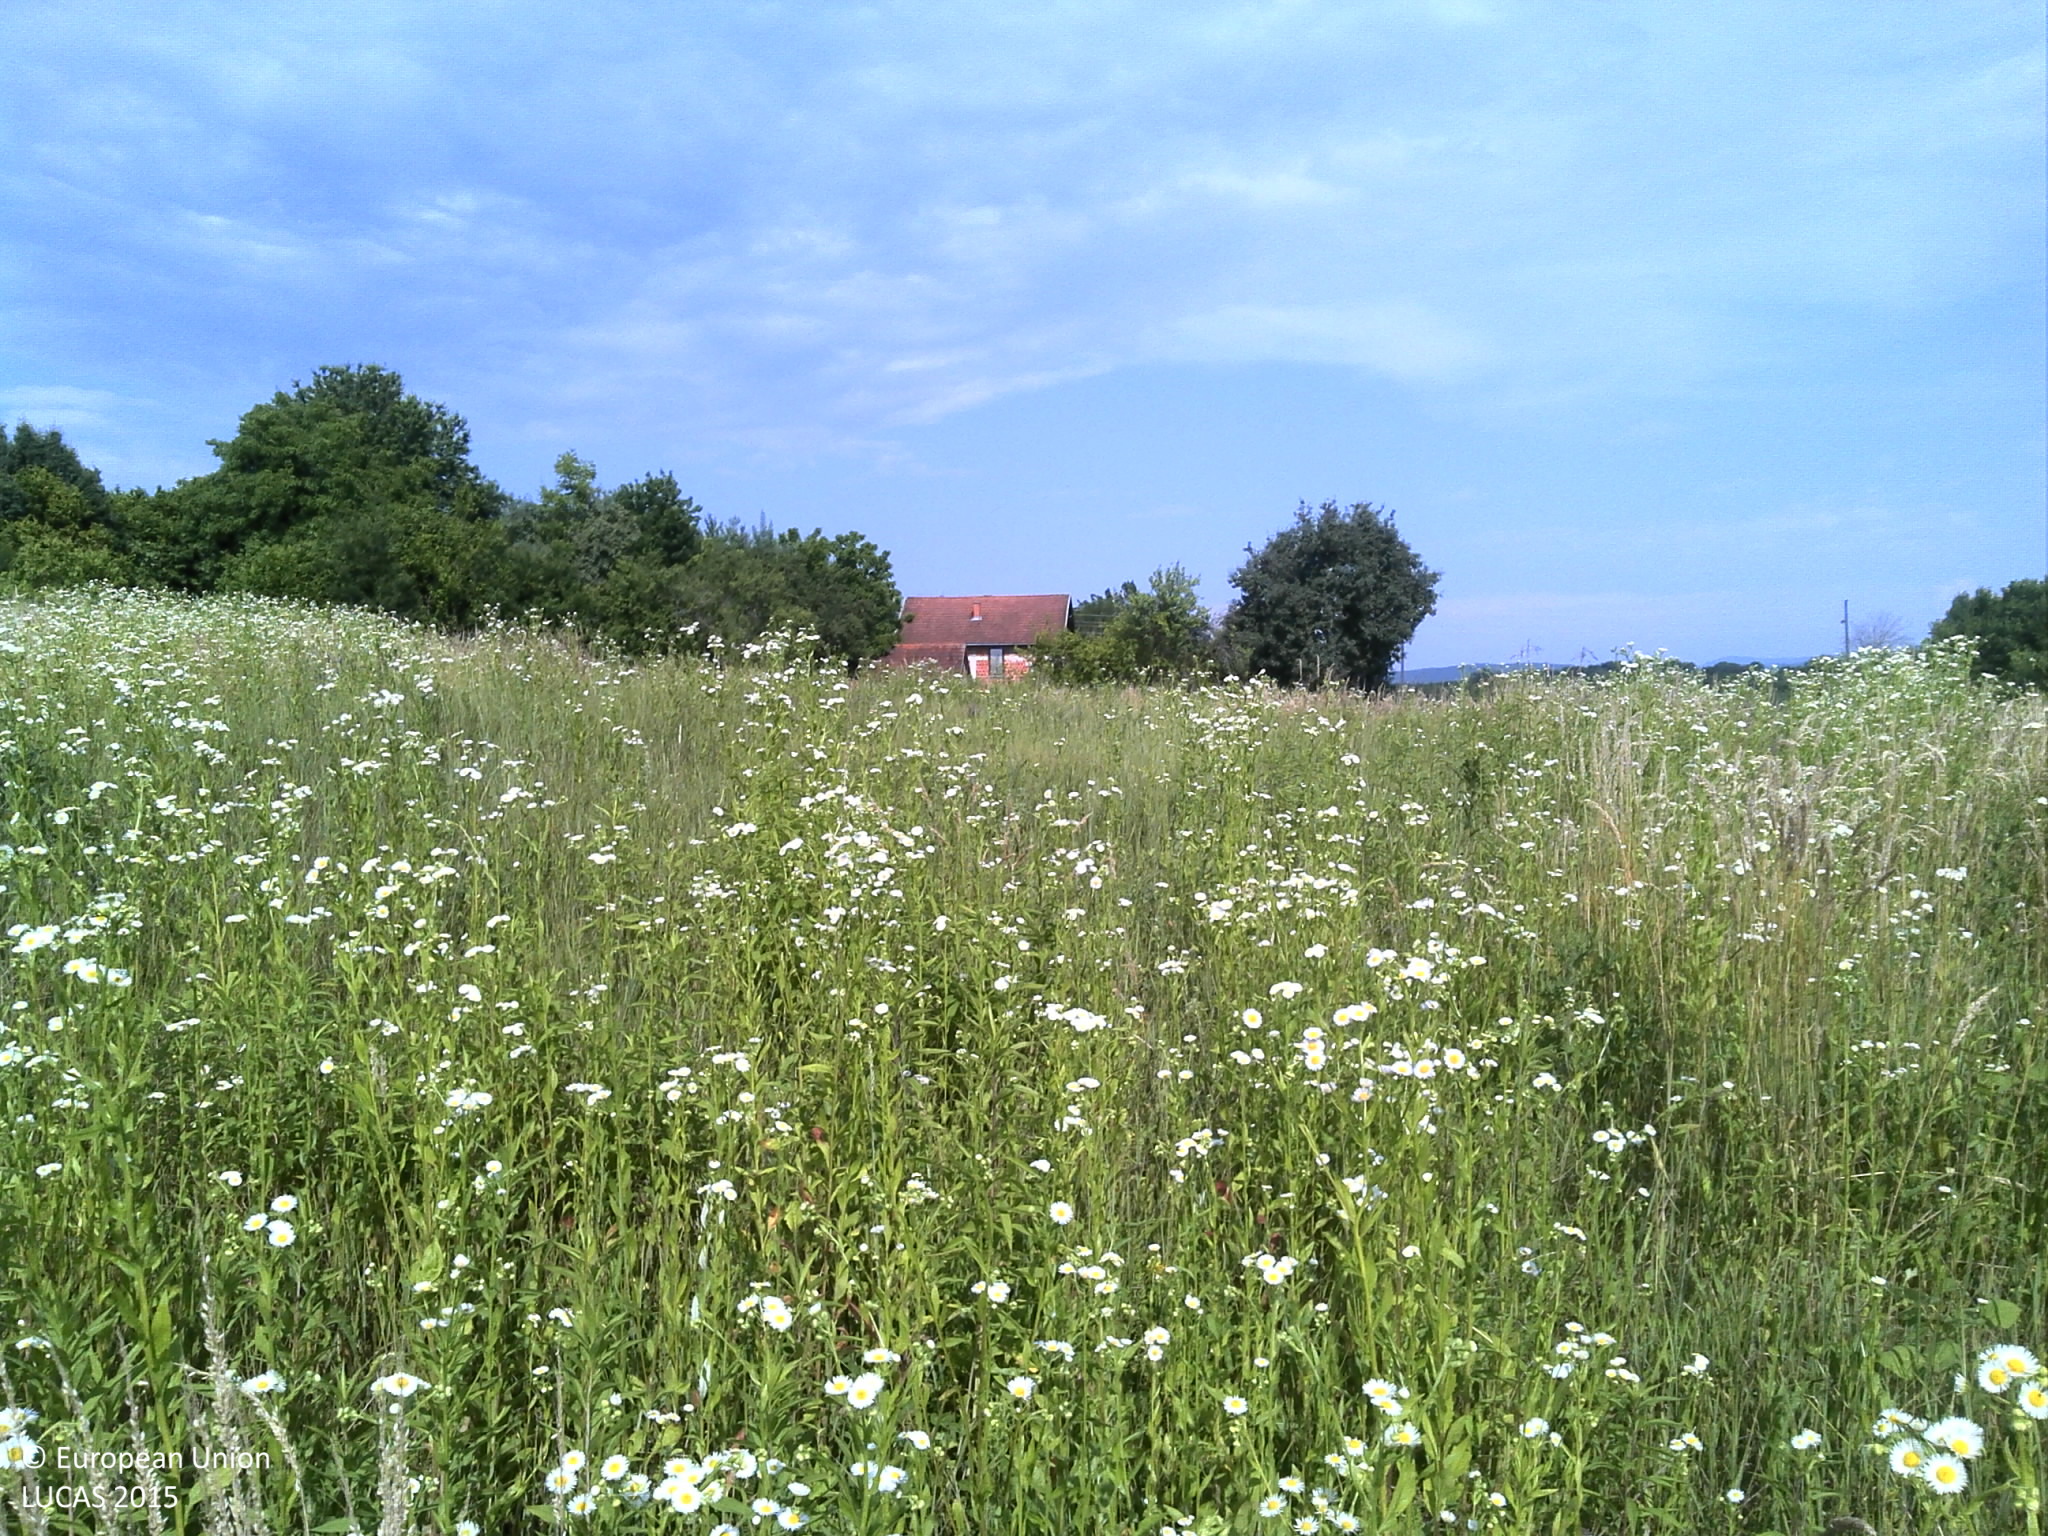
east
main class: Grassland
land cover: Spontaneously vegetated surfaces
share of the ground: > 75 %
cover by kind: herbaceous plants 100 %
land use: Semi-natural and natural areas not in use
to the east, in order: Spontaneously vegetated surfaces; Other fruit trees and berries; Artificial constructions in urban areas; Shrubland with sparse tree cover
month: June
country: HR
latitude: 45.4609
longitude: 17.1490
